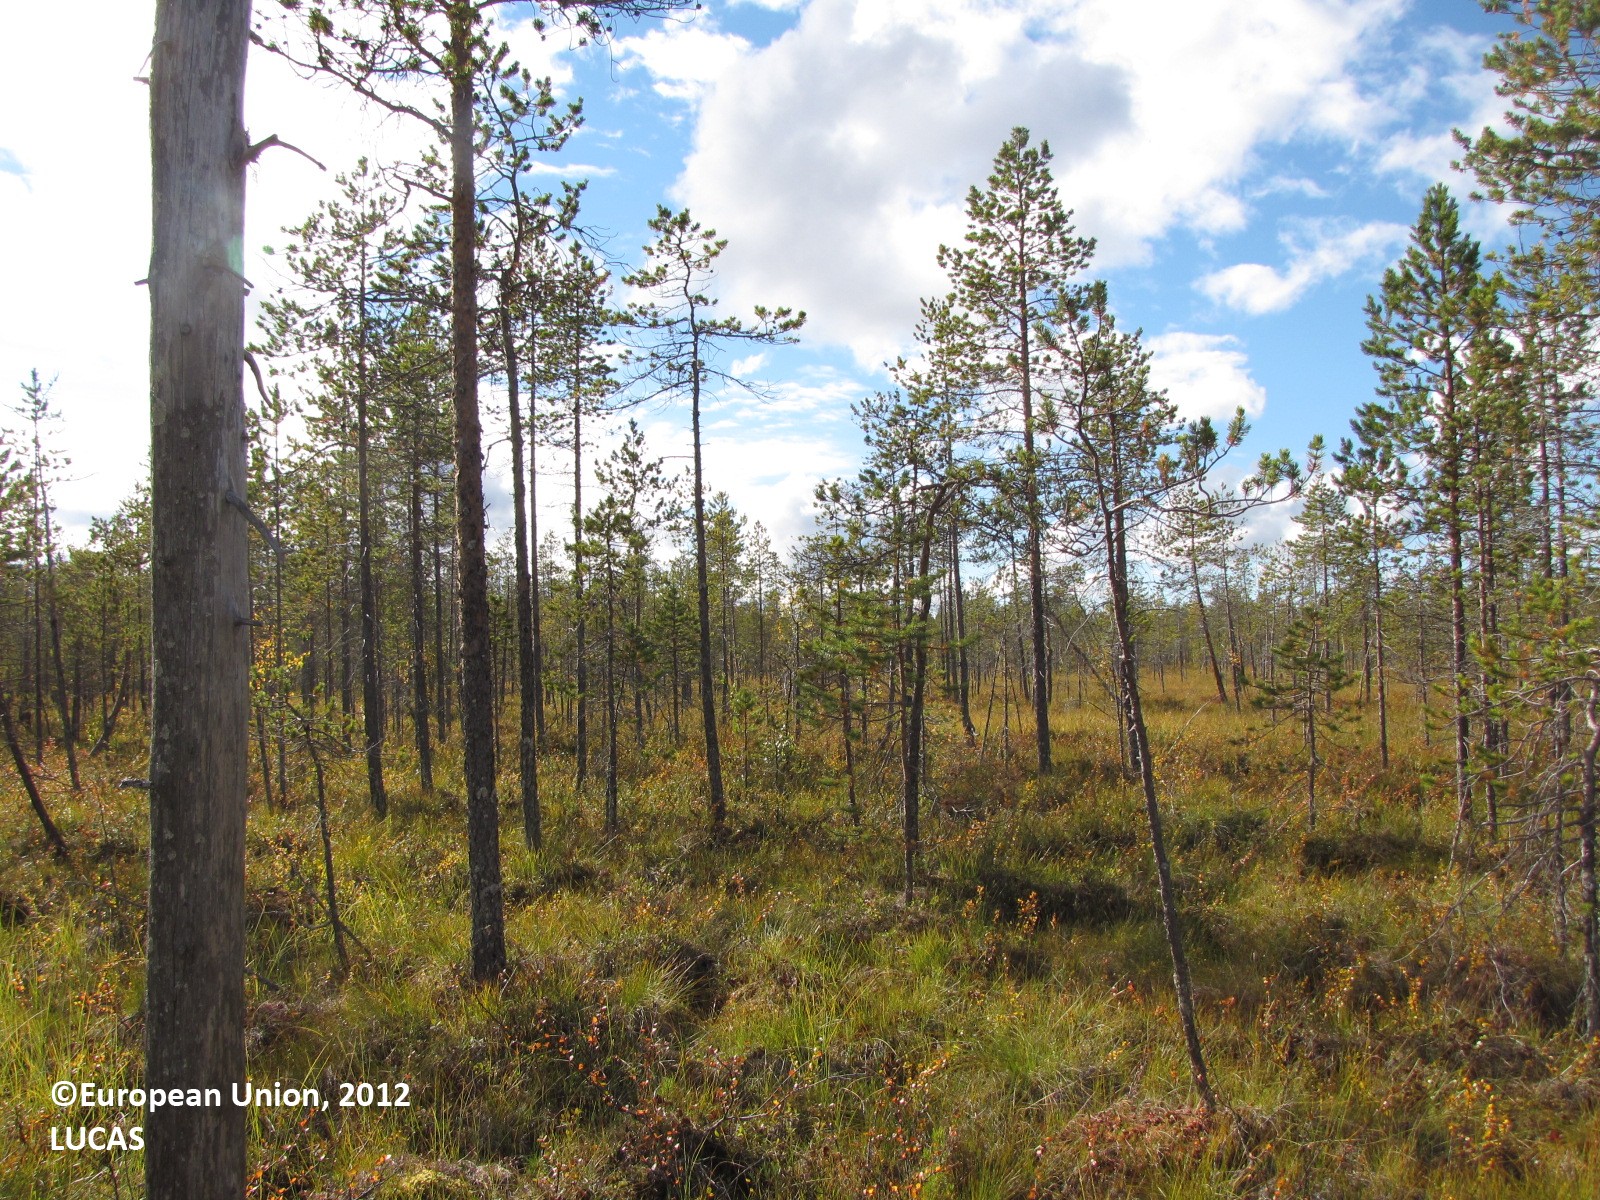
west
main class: Woodland
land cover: Pine dominated coniferous woodland
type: boreal forest
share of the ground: 25 - 50 %
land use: Forestry
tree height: > 5 m
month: September
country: FI
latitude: 67.3882
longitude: 24.8854
